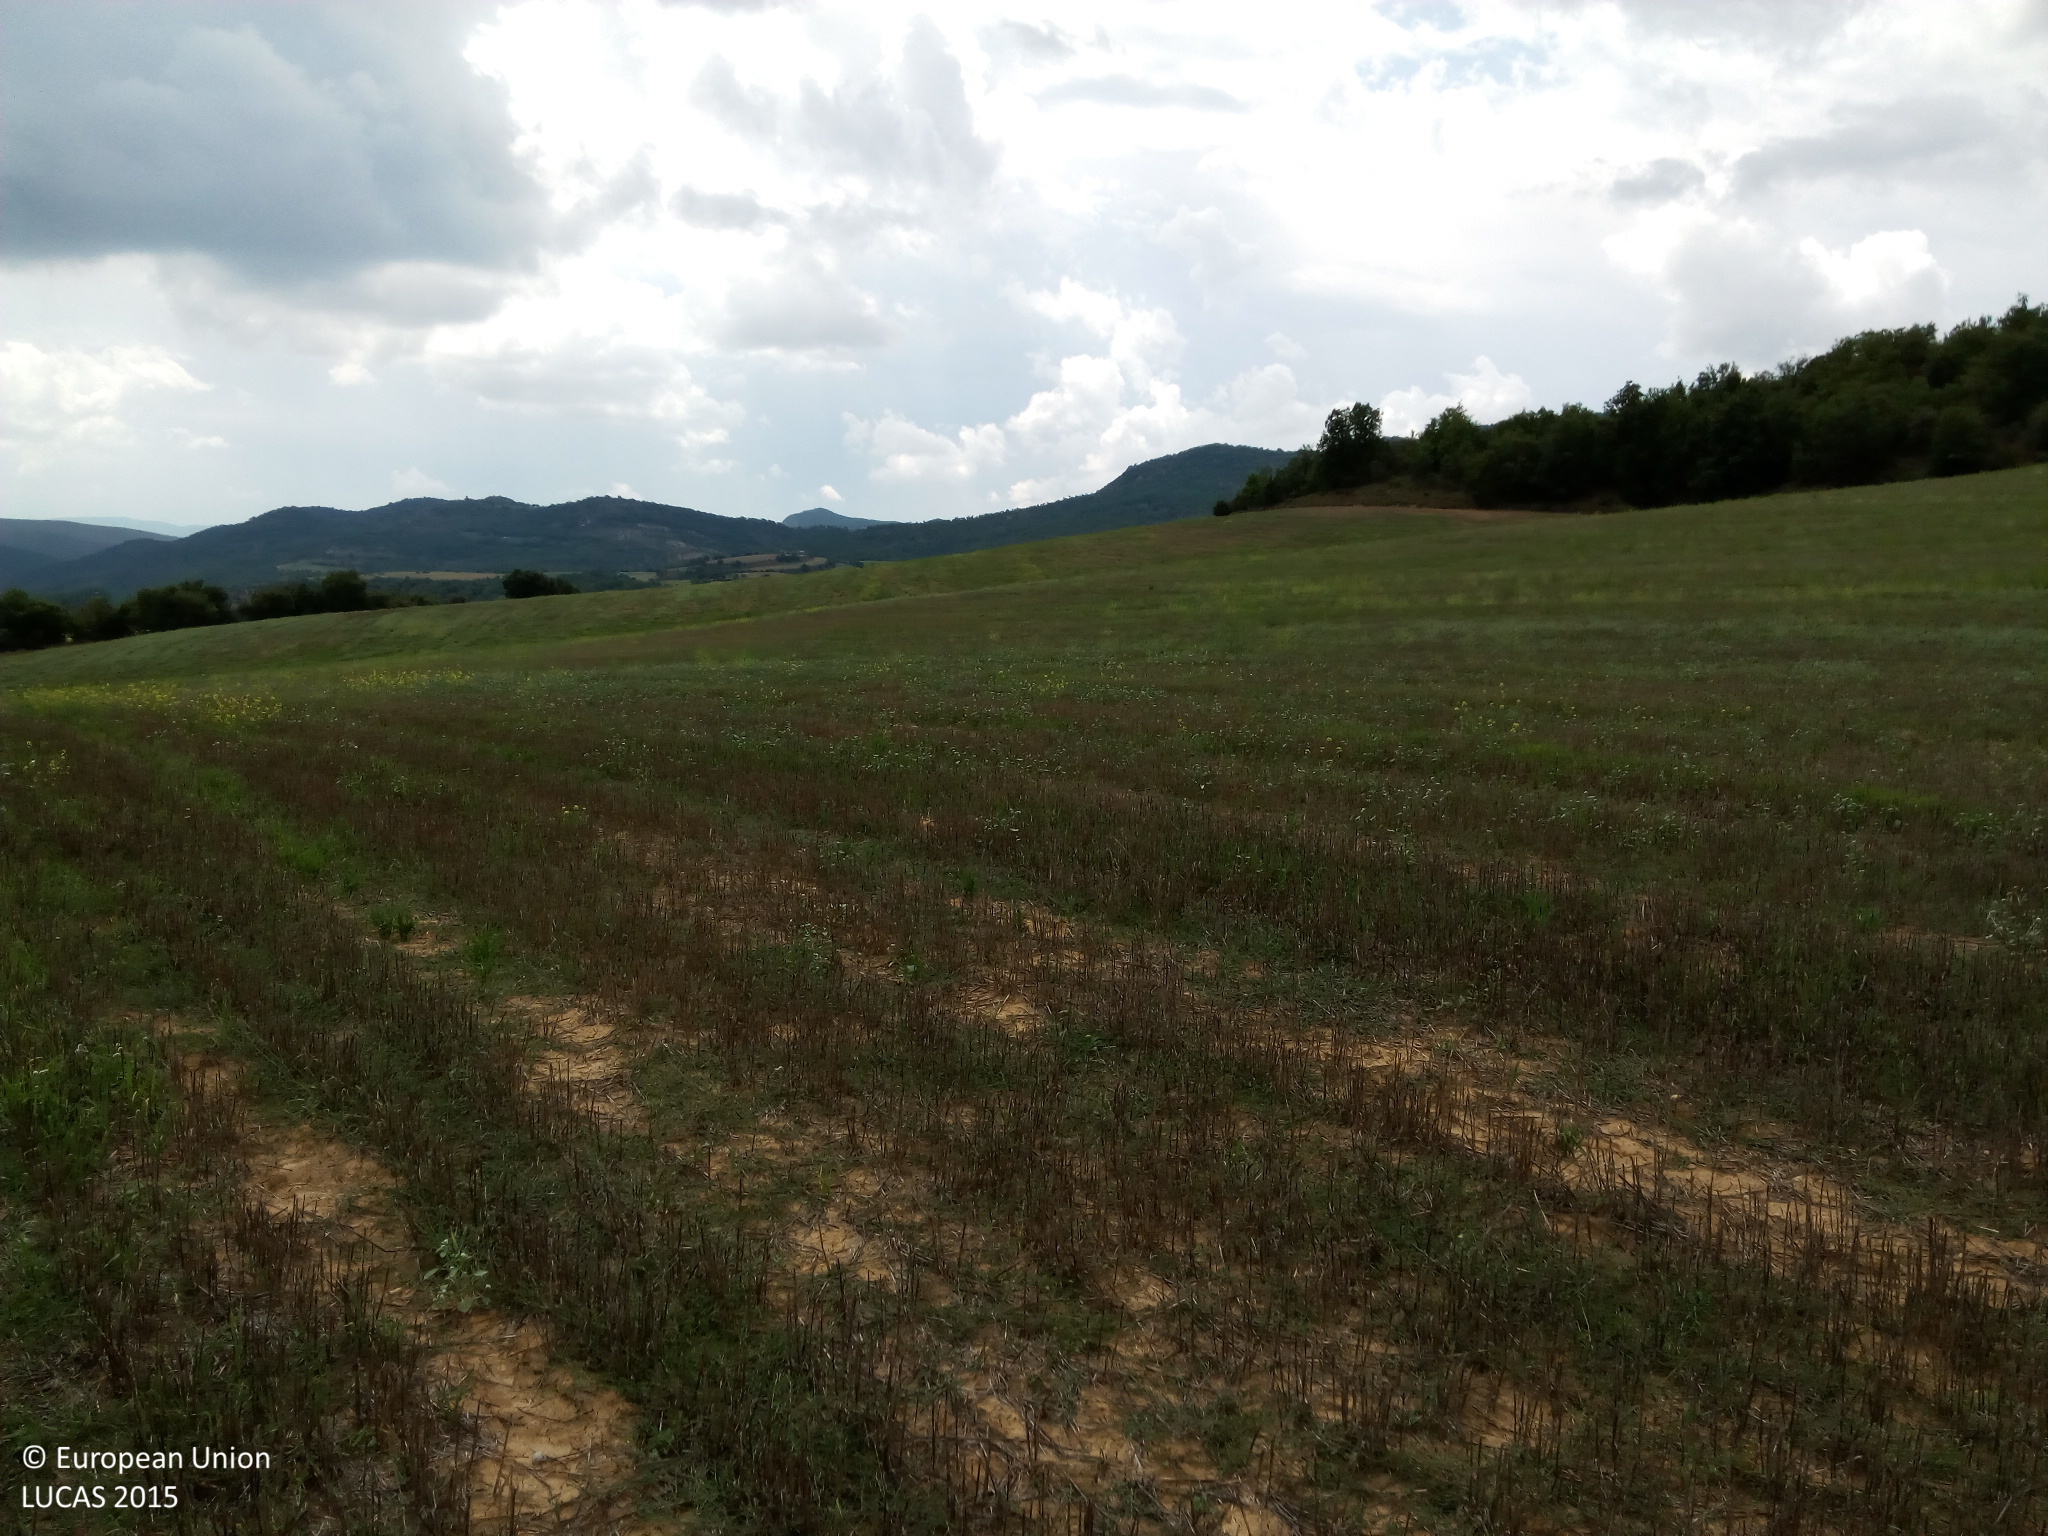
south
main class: Grassland
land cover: Spontaneously vegetated surfaces
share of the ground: > 75 %
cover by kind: unconsolidated bare surface 60 %, herbaceous plants 40 %
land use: Fallow land
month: August
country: ES
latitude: 42.0655
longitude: 0.5453
